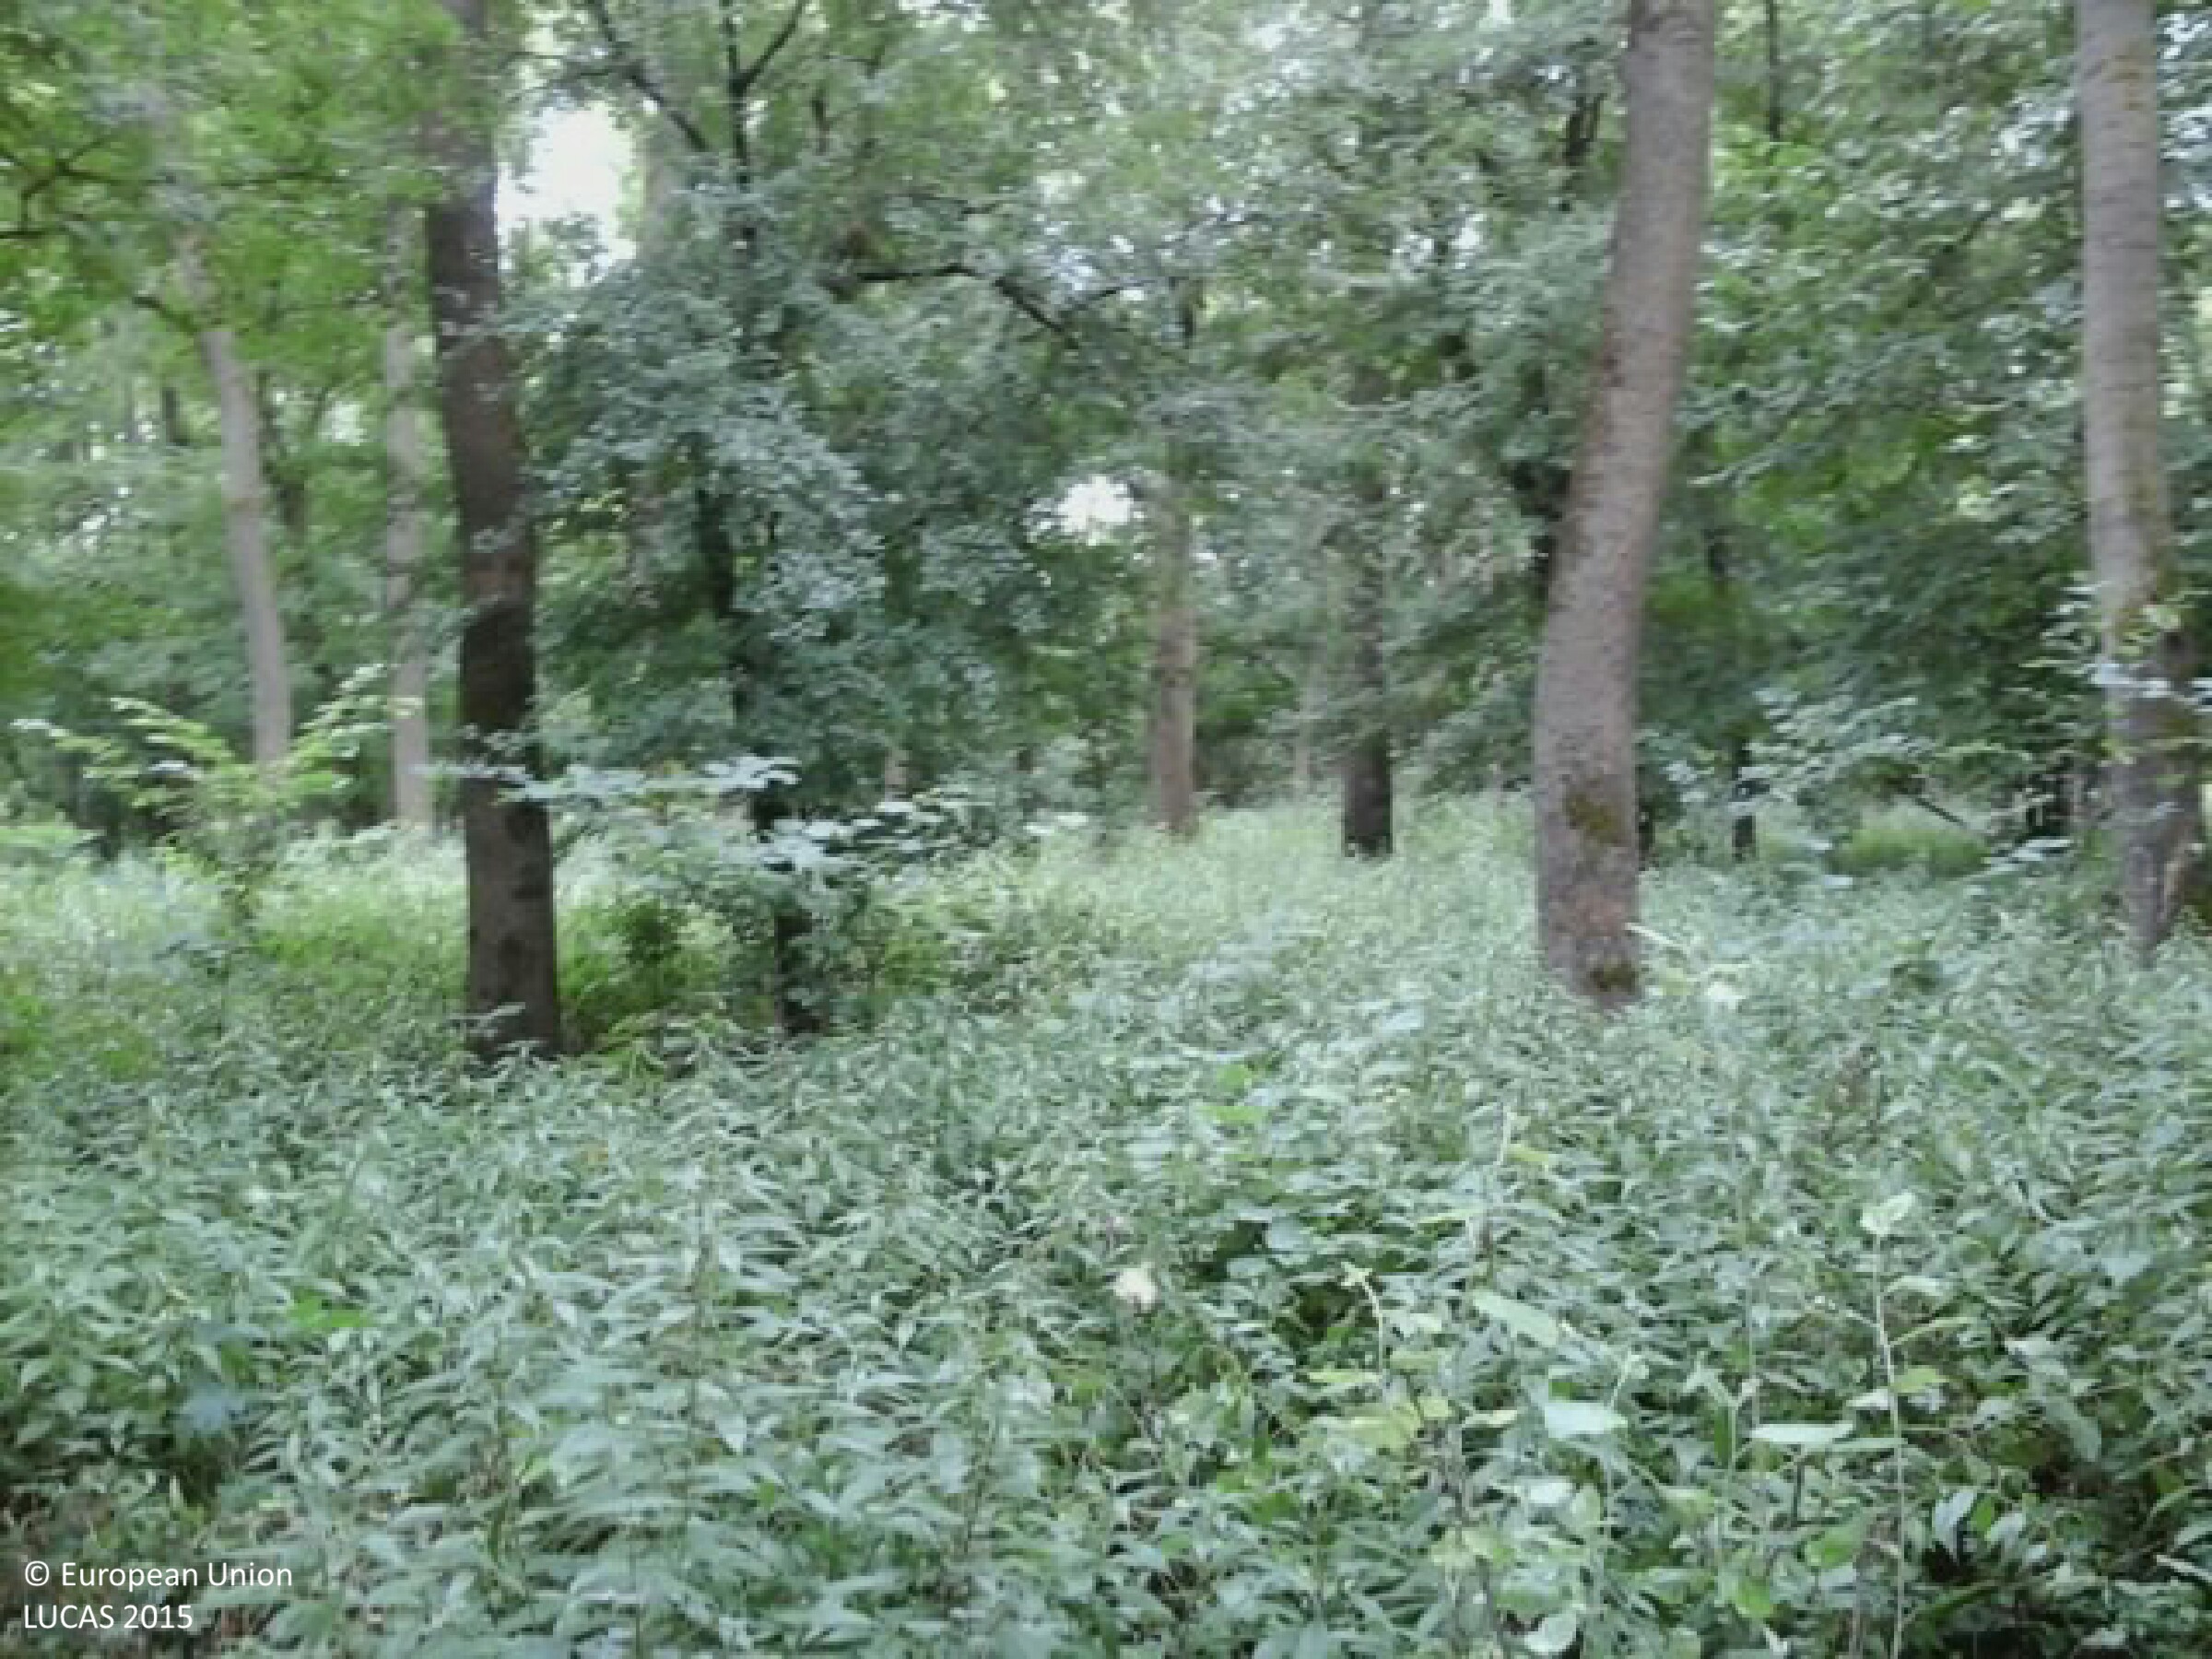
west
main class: Woodland
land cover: Broadleaved woodland
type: mesophytic deciduous forest
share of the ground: 50 - 75 %
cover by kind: broadleaved forest trees 65 %, herbaceous plants 20 %, shrubs 15 %
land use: Forestry
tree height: > 5 m
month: July
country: HU
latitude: 46.3095
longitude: 18.8547
